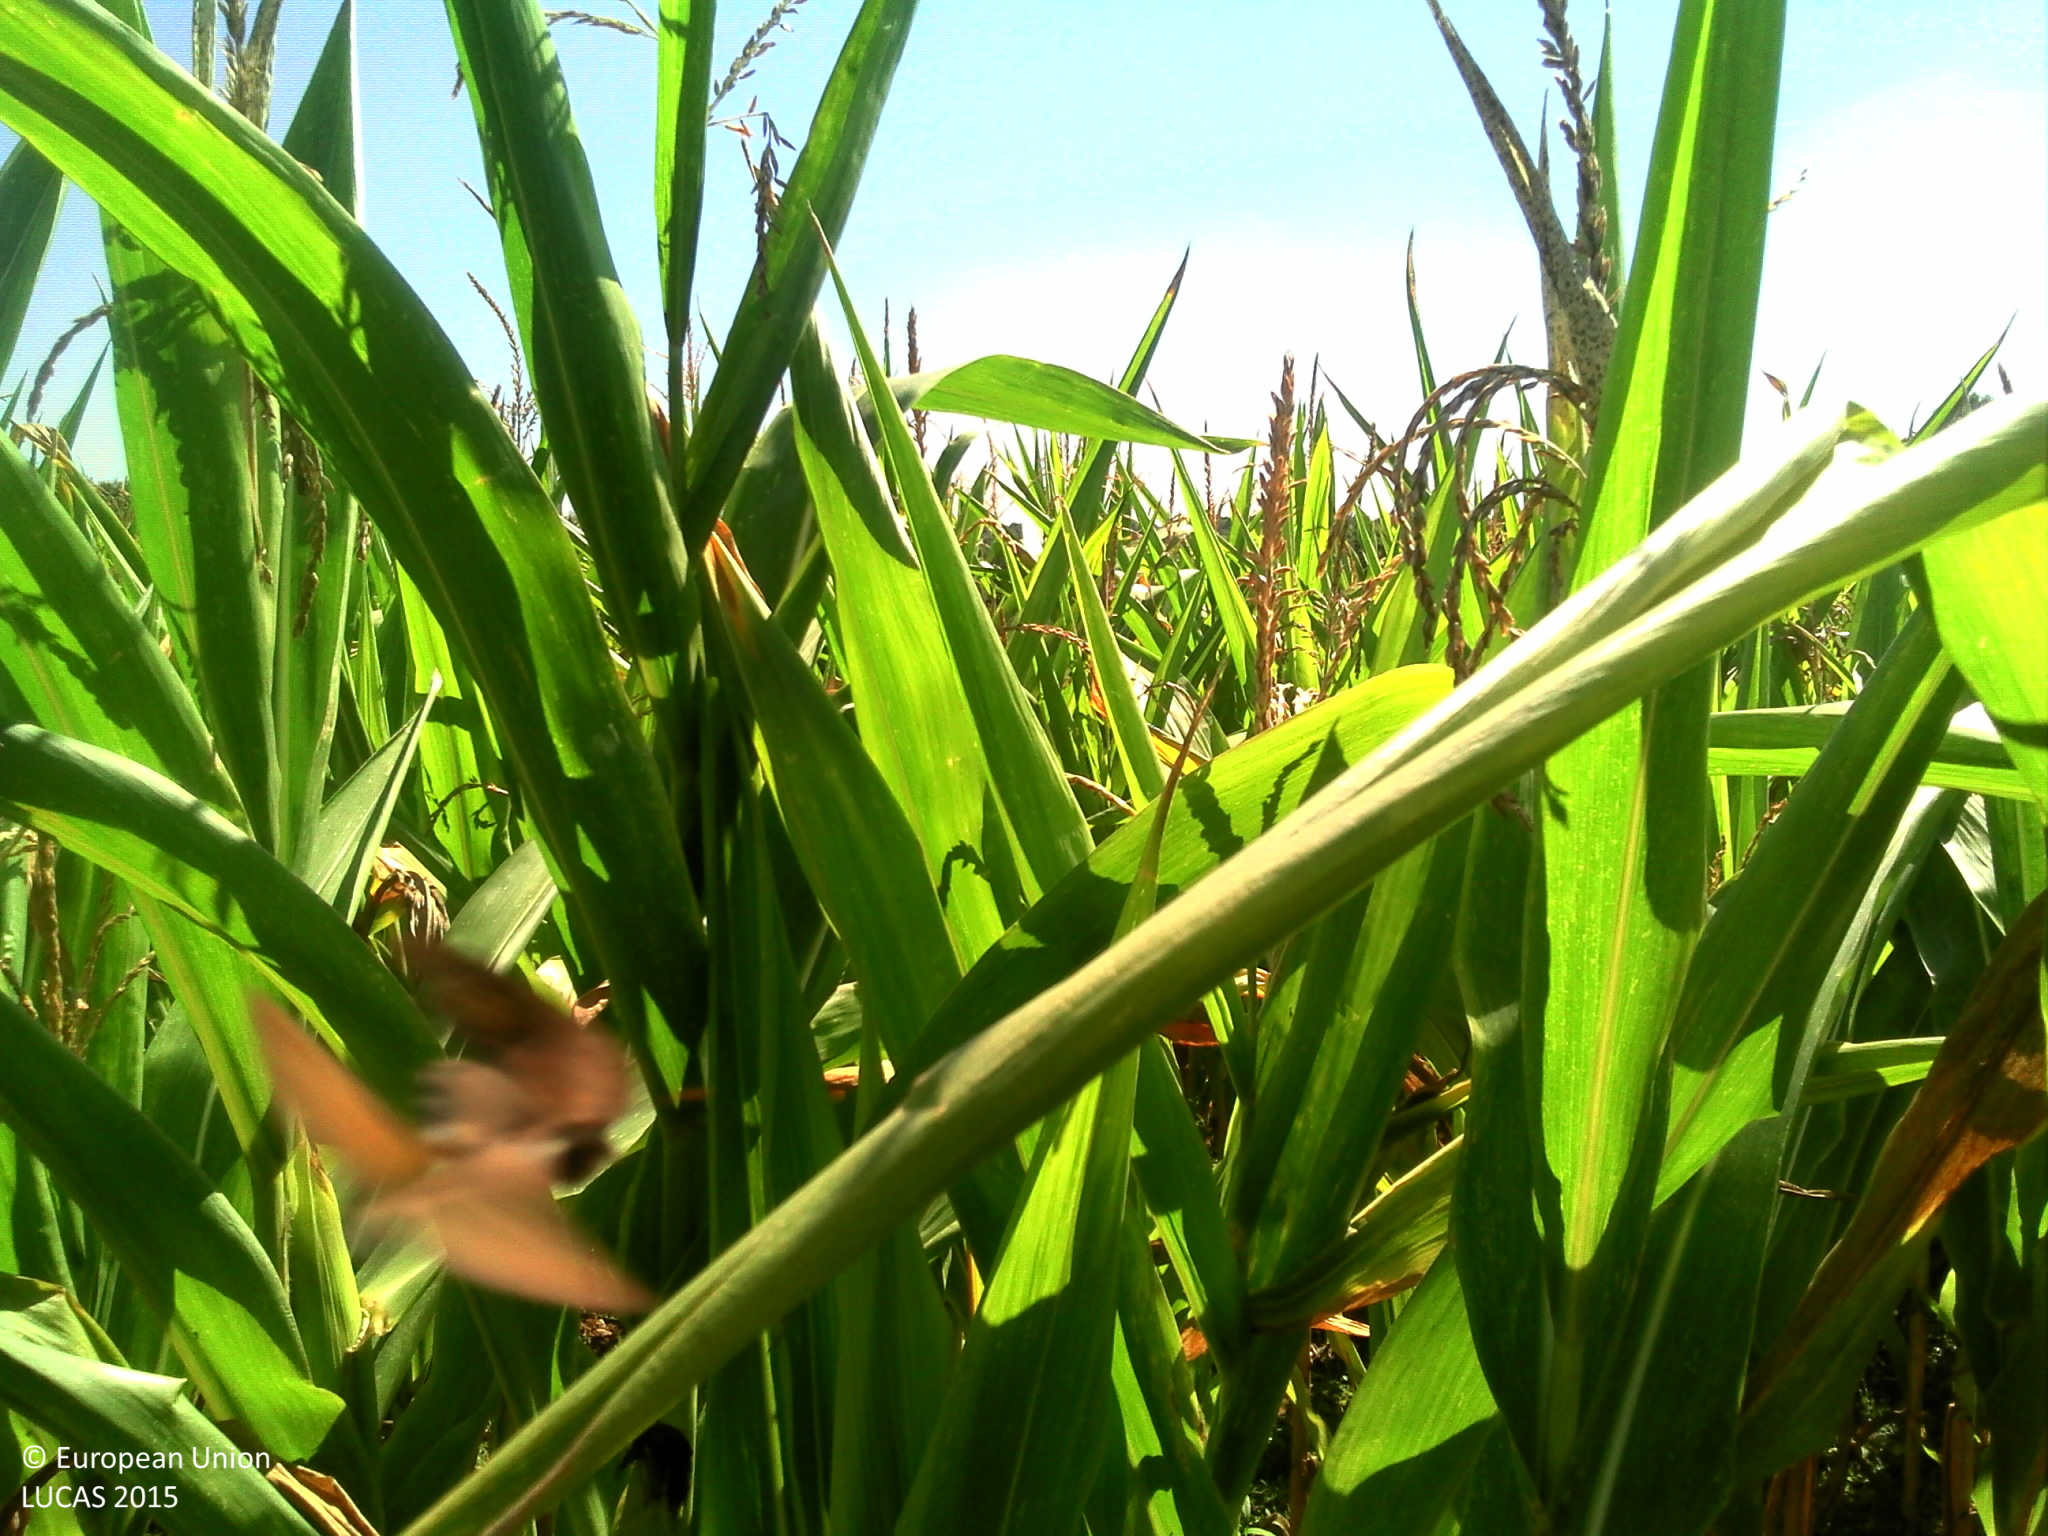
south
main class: Cropland
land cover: Maize
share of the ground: > 75 %
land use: Agriculture (excluding fallow land and kitchen gardens)
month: August
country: FR
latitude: 46.1828
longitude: 0.9315
